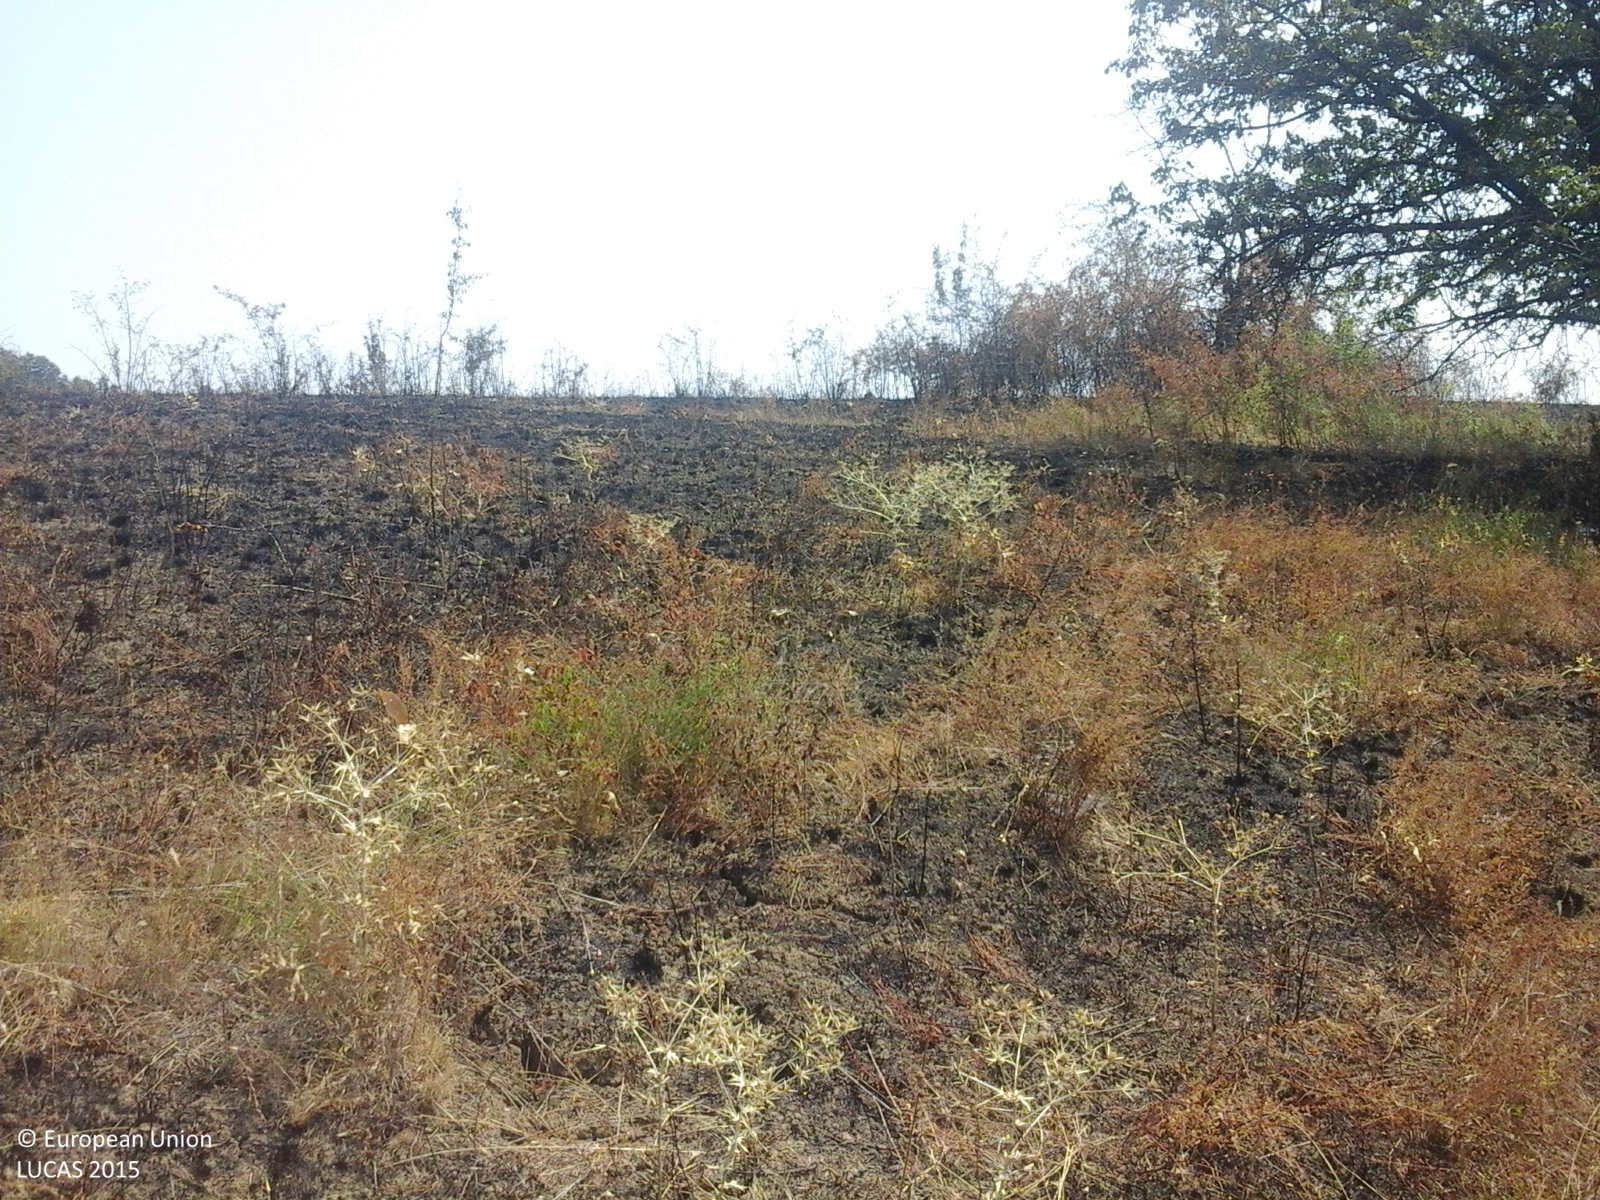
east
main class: Grassland
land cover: Grassland with sparse tree/shrub cover
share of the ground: > 75 %
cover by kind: herbaceous plants 85 %, shrubs 10 %, broadleaved forest trees 5 %
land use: Agriculture (excluding fallow land and kitchen gardens)
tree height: < 5 m
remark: Burnt area
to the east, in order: Grassland with sparse tree/shrub cover; Shrubland with sparse tree cover; Grassland with sparse tree/shrub cover; Tracks; Shrubland without tree cover; Grassland with sparse tree/shrub cover; Broadleaved woodland
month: August
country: RO
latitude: 44.5206
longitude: 23.0940
